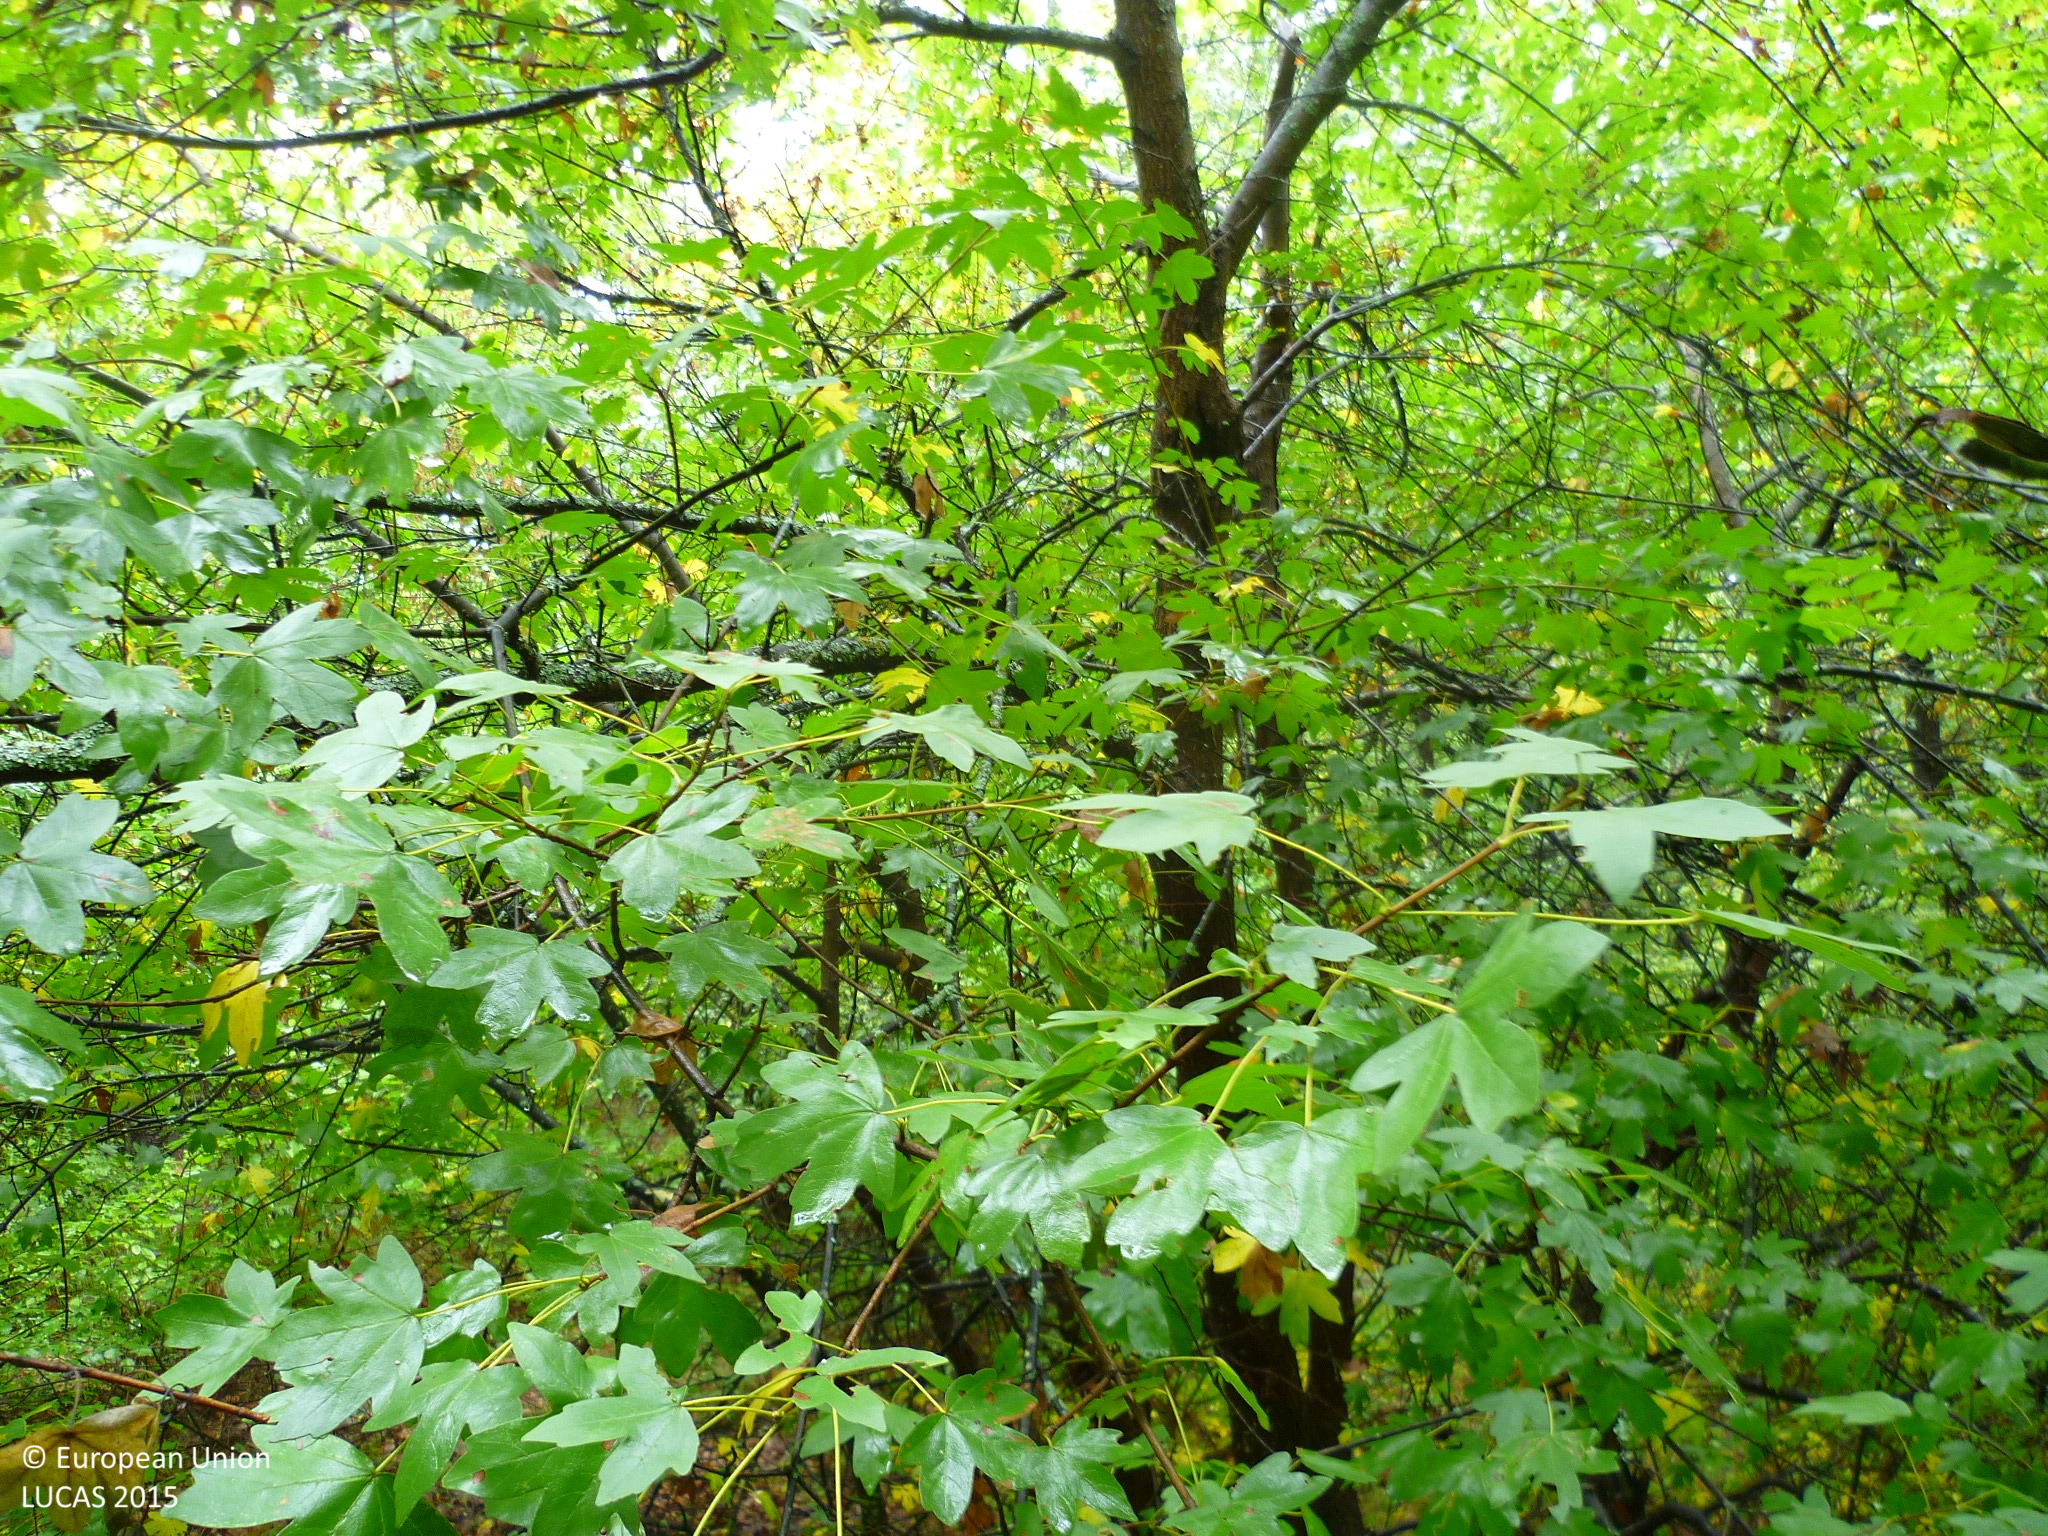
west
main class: Woodland
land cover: Broadleaved woodland
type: mesophytic deciduous forest
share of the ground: > 75 %
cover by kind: broadleaved forest trees 95 %, herbaceous plants 5 %
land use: Forestry
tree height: > 5 m
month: October
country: BG
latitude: 42.6361
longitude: 22.8440
